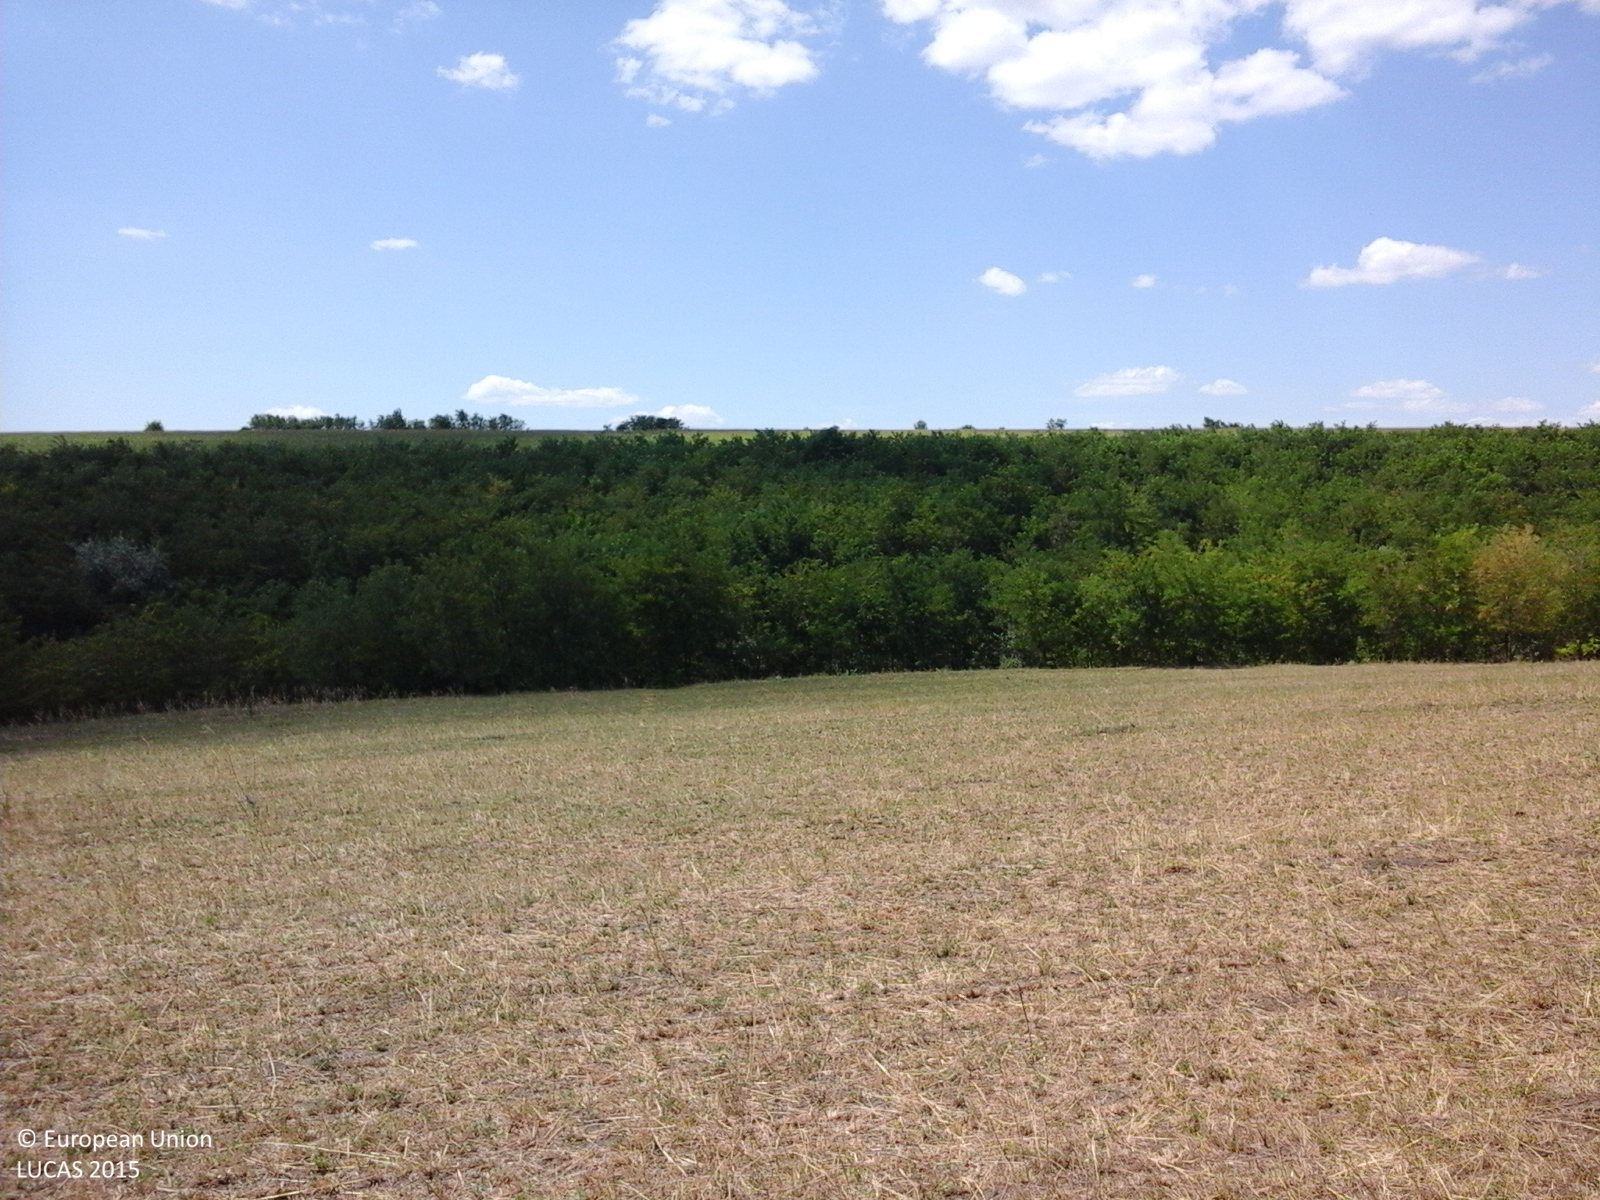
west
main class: Grassland
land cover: Grassland without tree/shrub cover
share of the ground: > 75 %
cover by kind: herbaceous plants 100 %
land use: Agriculture (excluding fallow land and kitchen gardens)
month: July
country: RO
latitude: 45.8825
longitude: 27.7532
